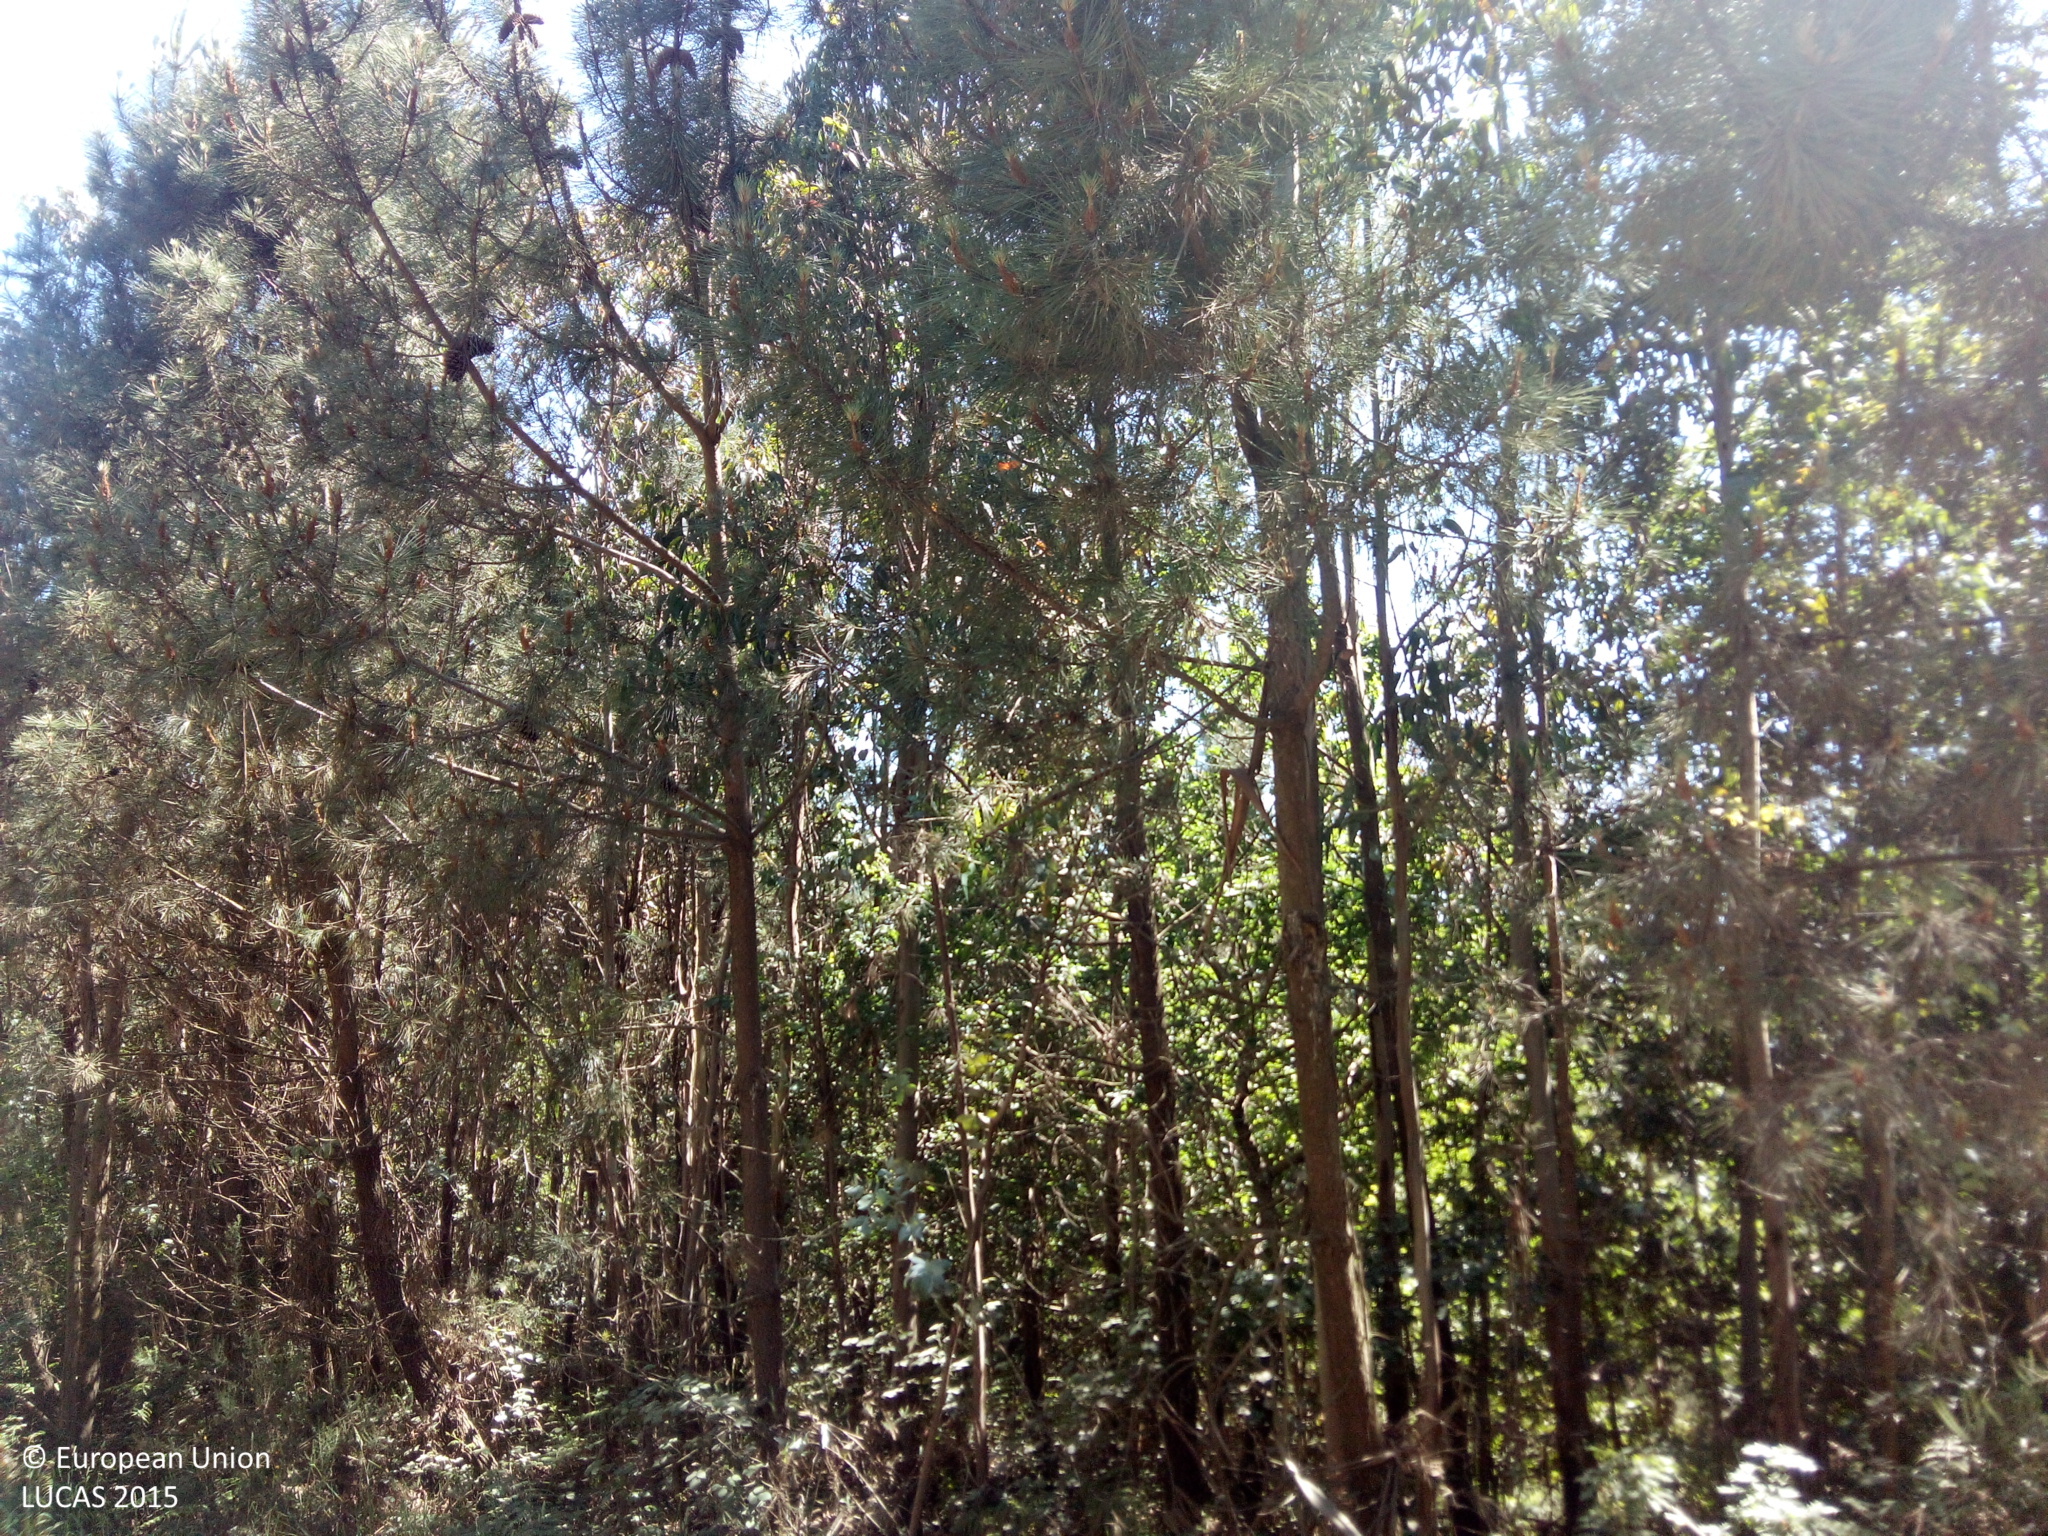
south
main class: Woodland
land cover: Pine dominated mixed woodland
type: hemiboreal forest and nemoral coniferous forest and mixed broadleaved-coniferous forest
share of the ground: > 75 %
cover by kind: coniferous forest trees 75 %, broadleaved forest trees 25 %
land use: Forestry
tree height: > 5 m
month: May
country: ES
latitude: 42.7935
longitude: -8.4265
